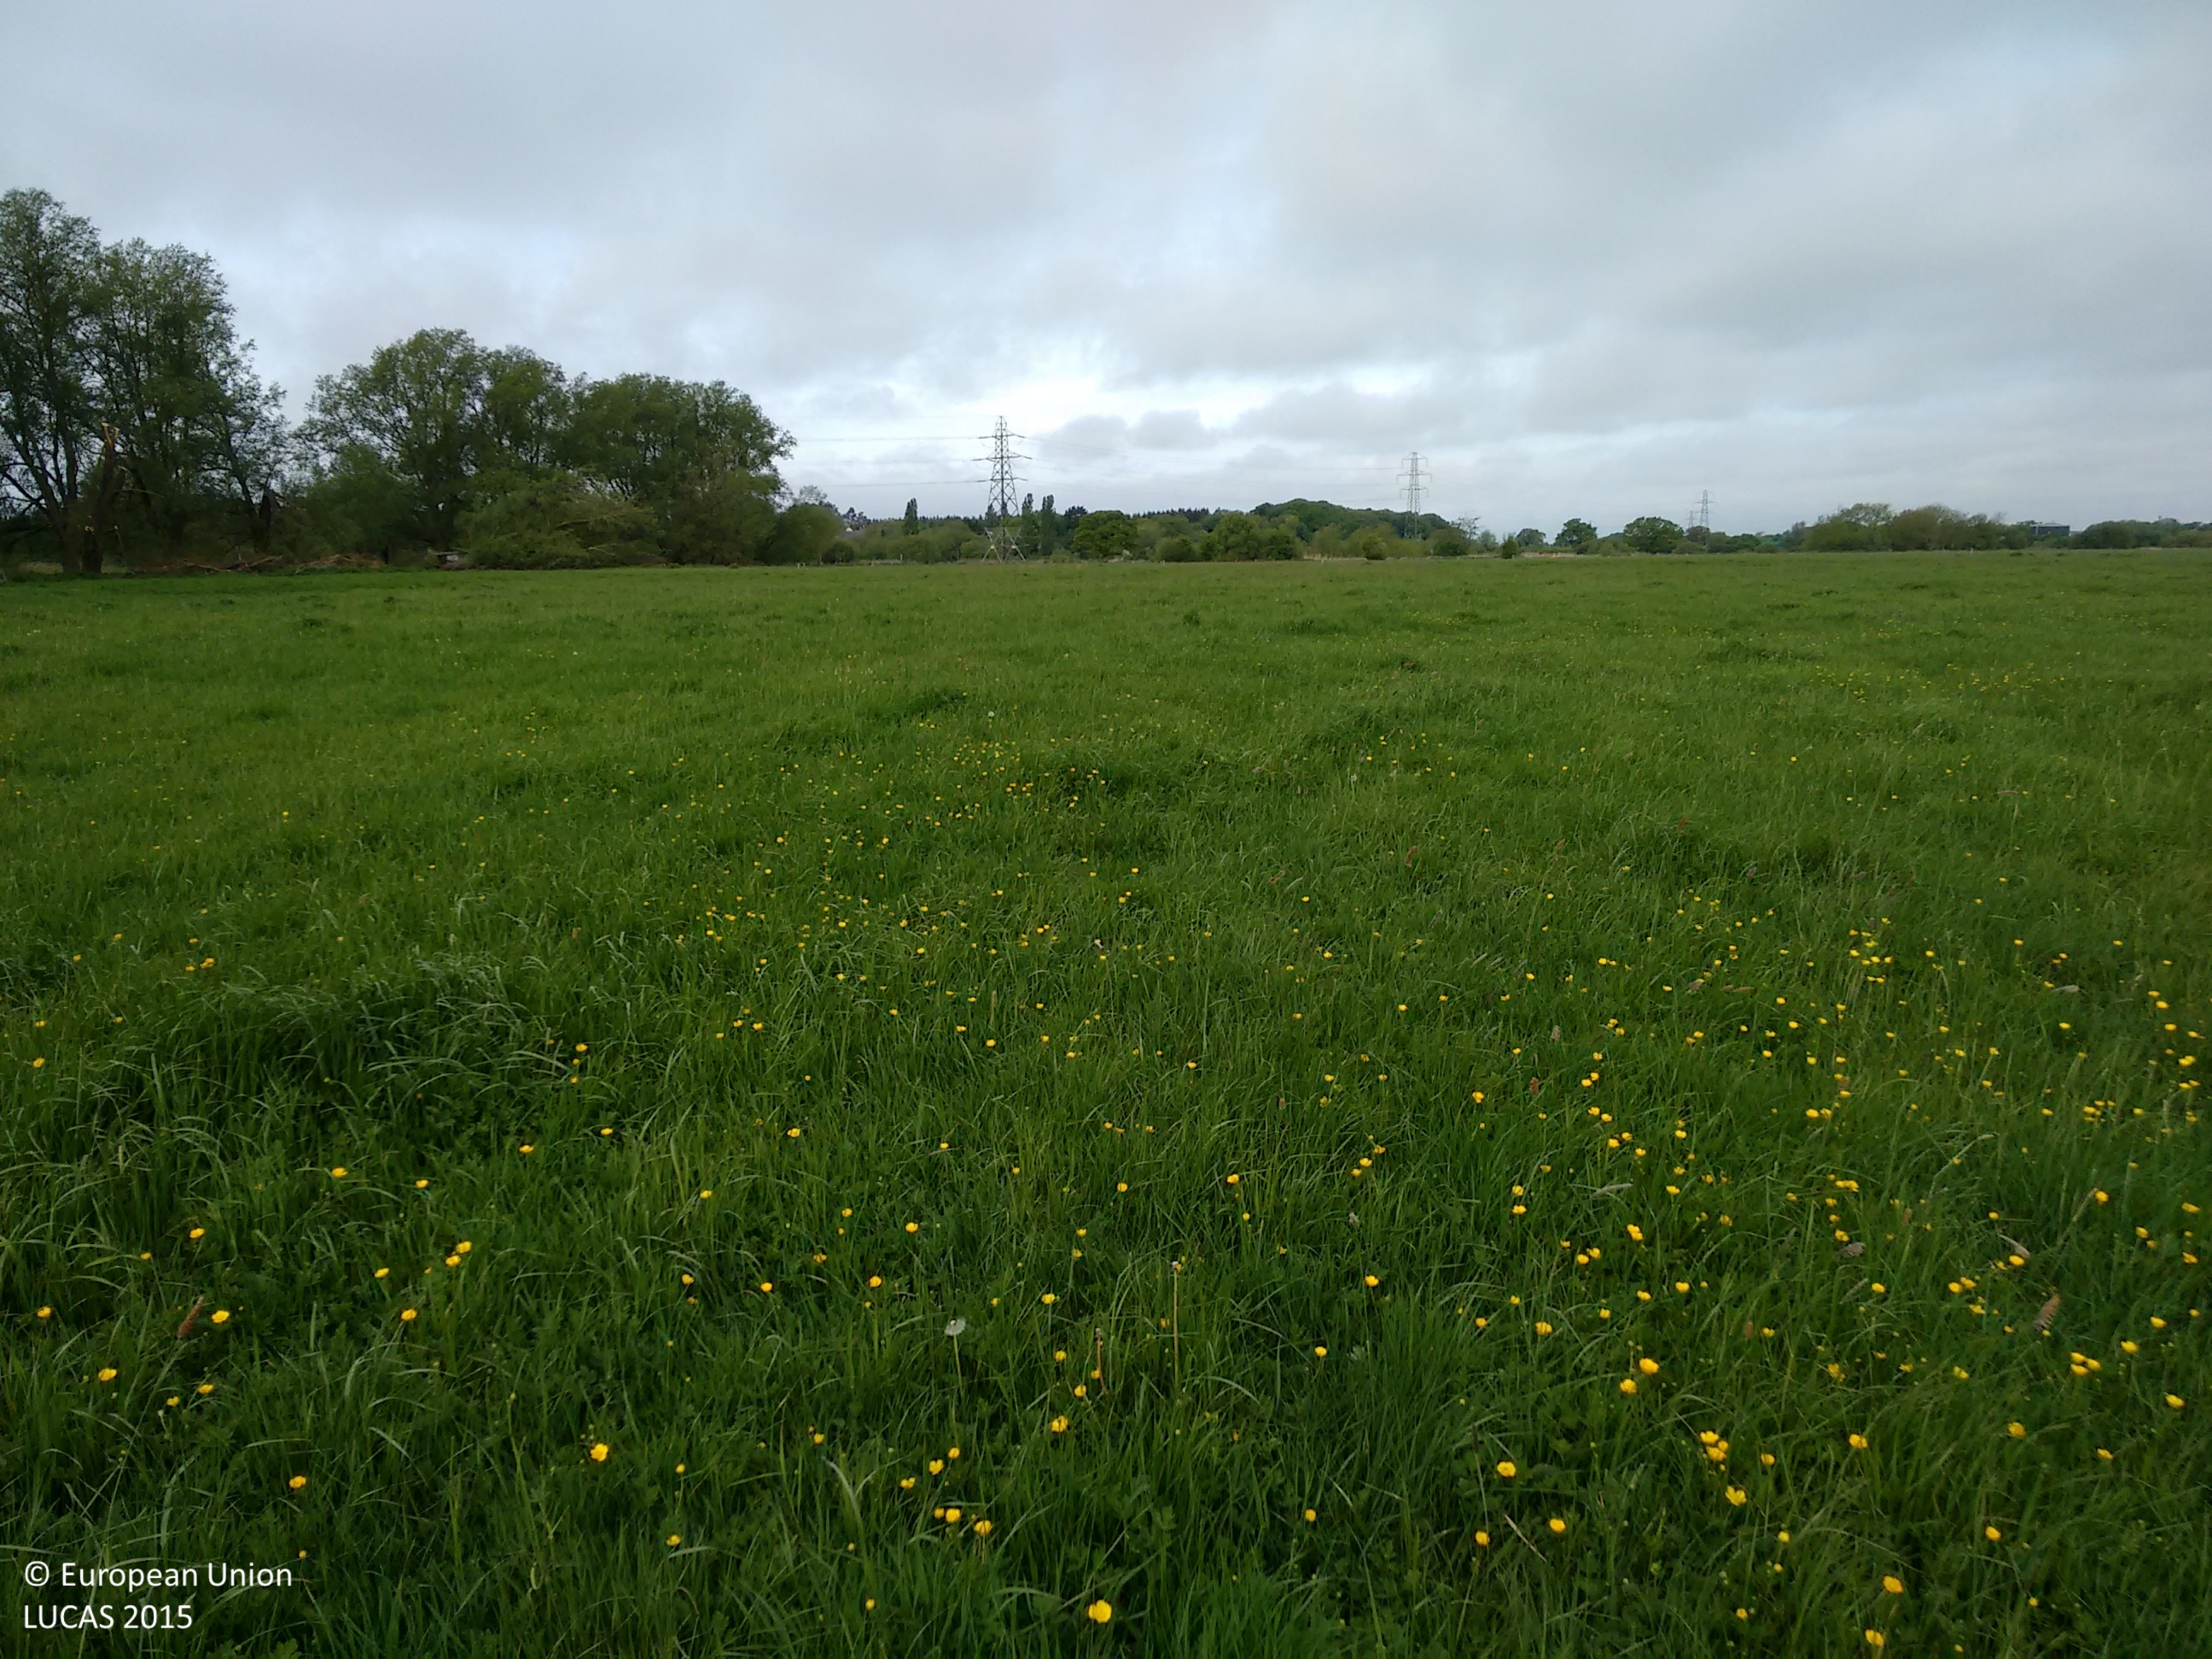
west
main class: Grassland
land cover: Grassland without tree/shrub cover
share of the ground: > 75 %
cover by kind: herbaceous plants 100 %
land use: Agriculture (excluding fallow land and kitchen gardens)
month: May
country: GB
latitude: 50.7647
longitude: -1.8376
